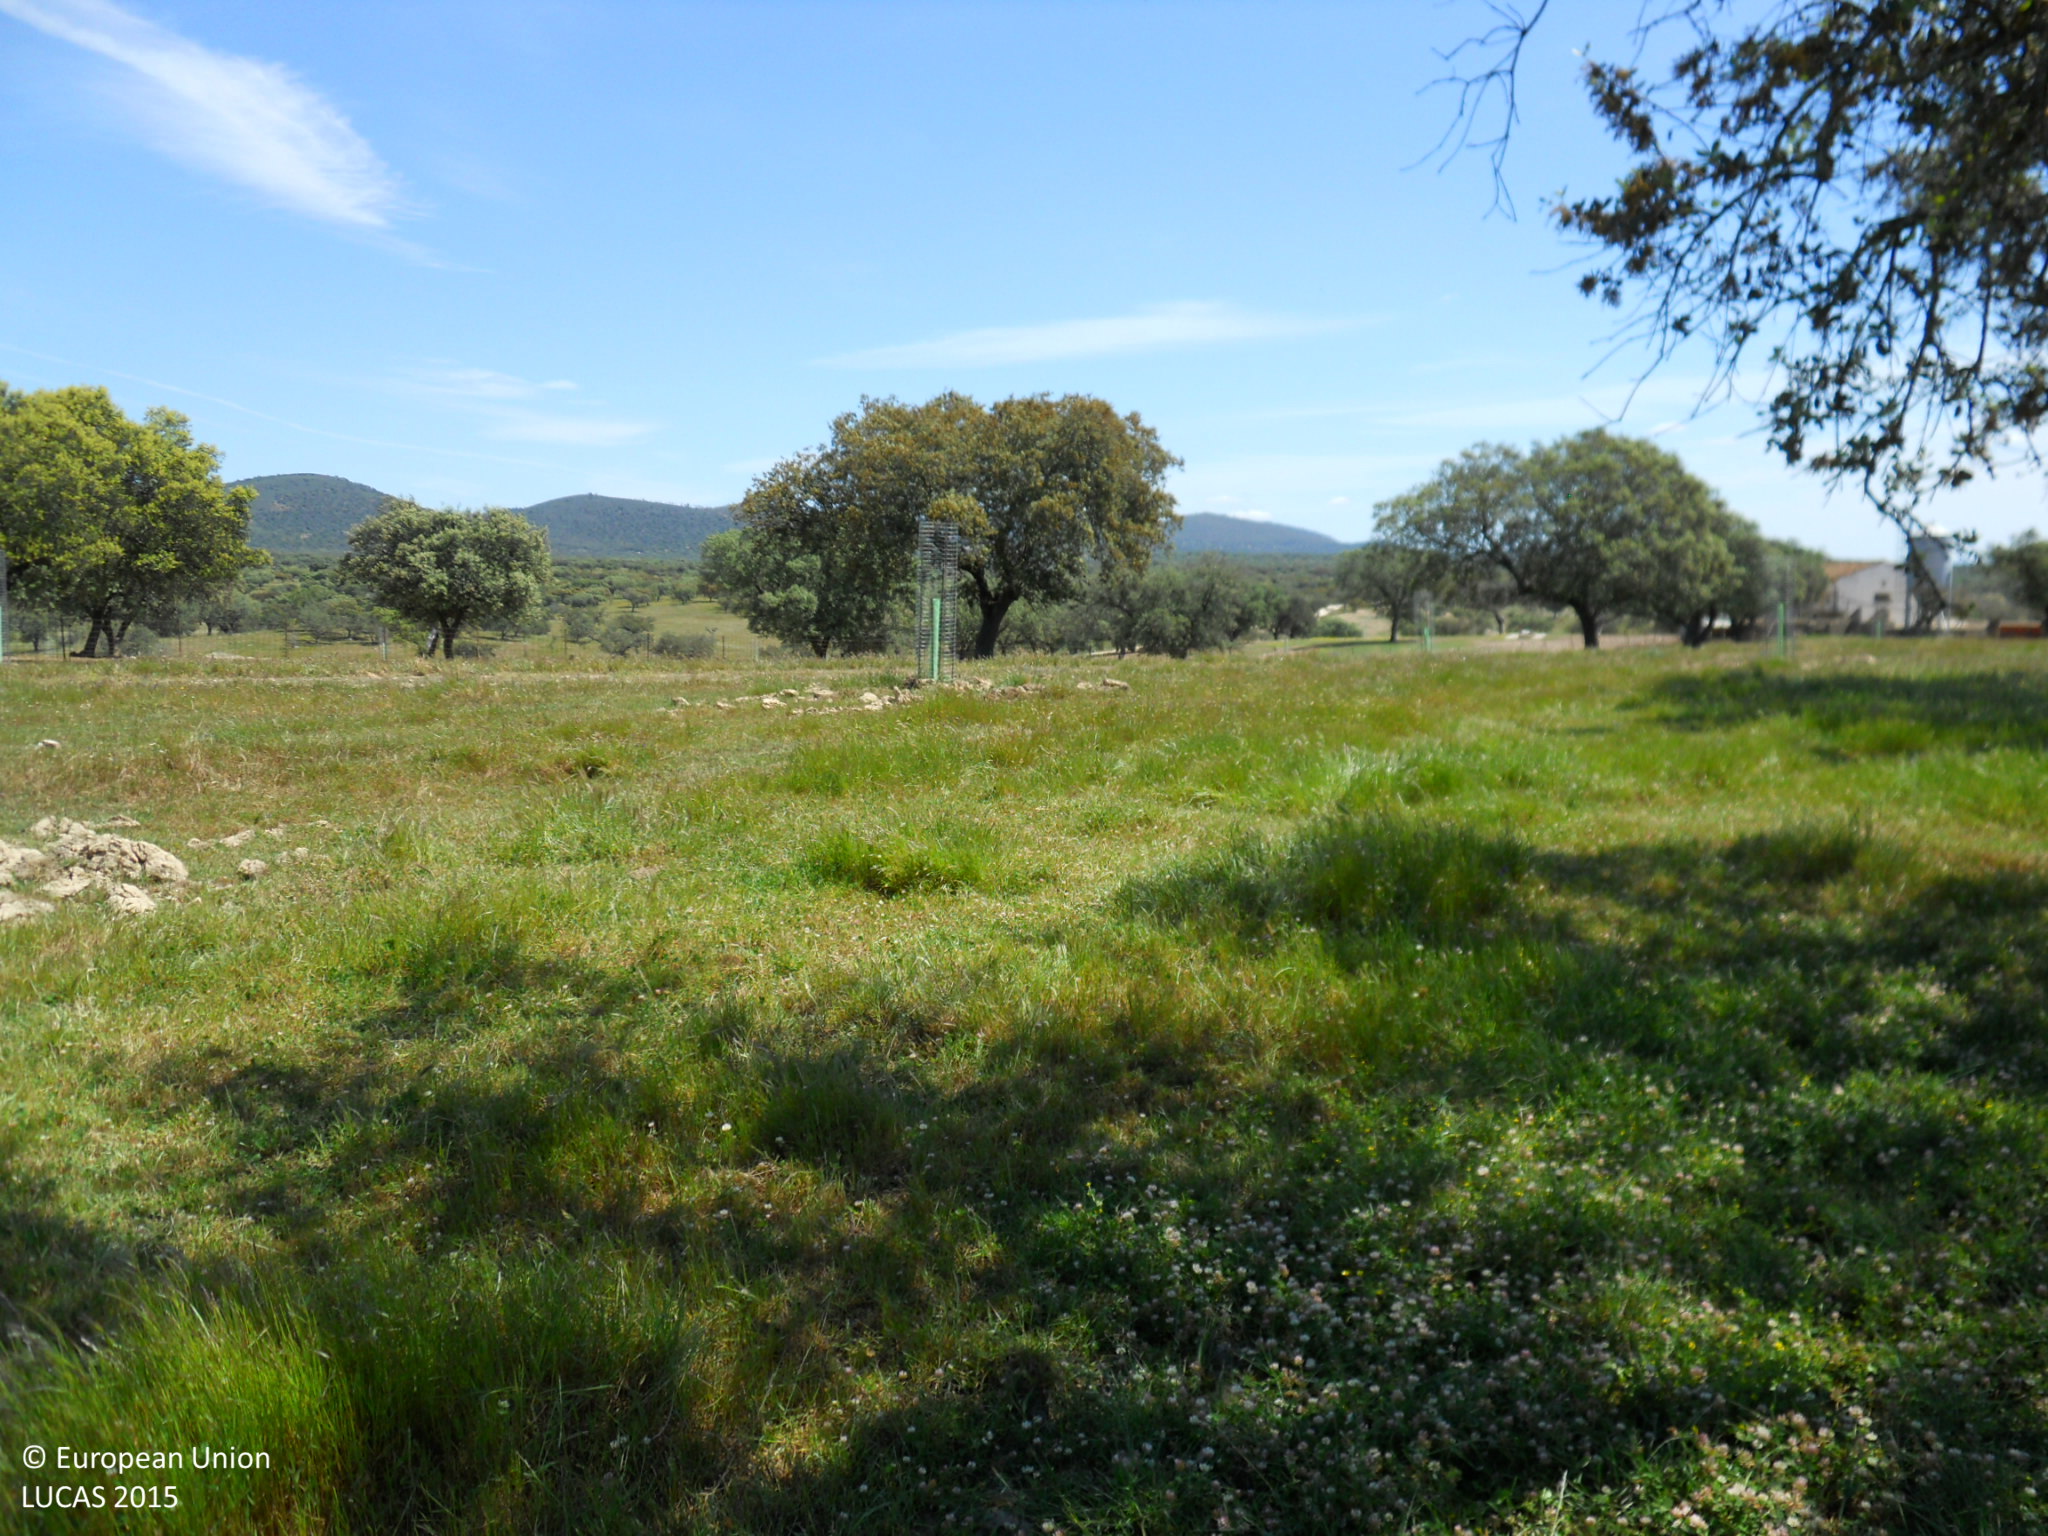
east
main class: Woodland
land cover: Broadleaved woodland
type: broadleaved evergreen forest
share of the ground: 25 - 50 %
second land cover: Grassland without tree/shrub cover
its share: > 75 %
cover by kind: herbaceous plants 65 %, broadleaved forest trees 35 %
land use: Forestry
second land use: Agriculture (excluding fallow land and kitchen gardens)
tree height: > 5 m
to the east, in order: Broadleaved woodland; Grassland without tree/shrub cover; Tracks; Broadleaved woodland; Fences; Other bare soil; Artificial constructions; Broadleaved woodland
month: April
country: ES
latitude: 39.3499
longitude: -6.9621
